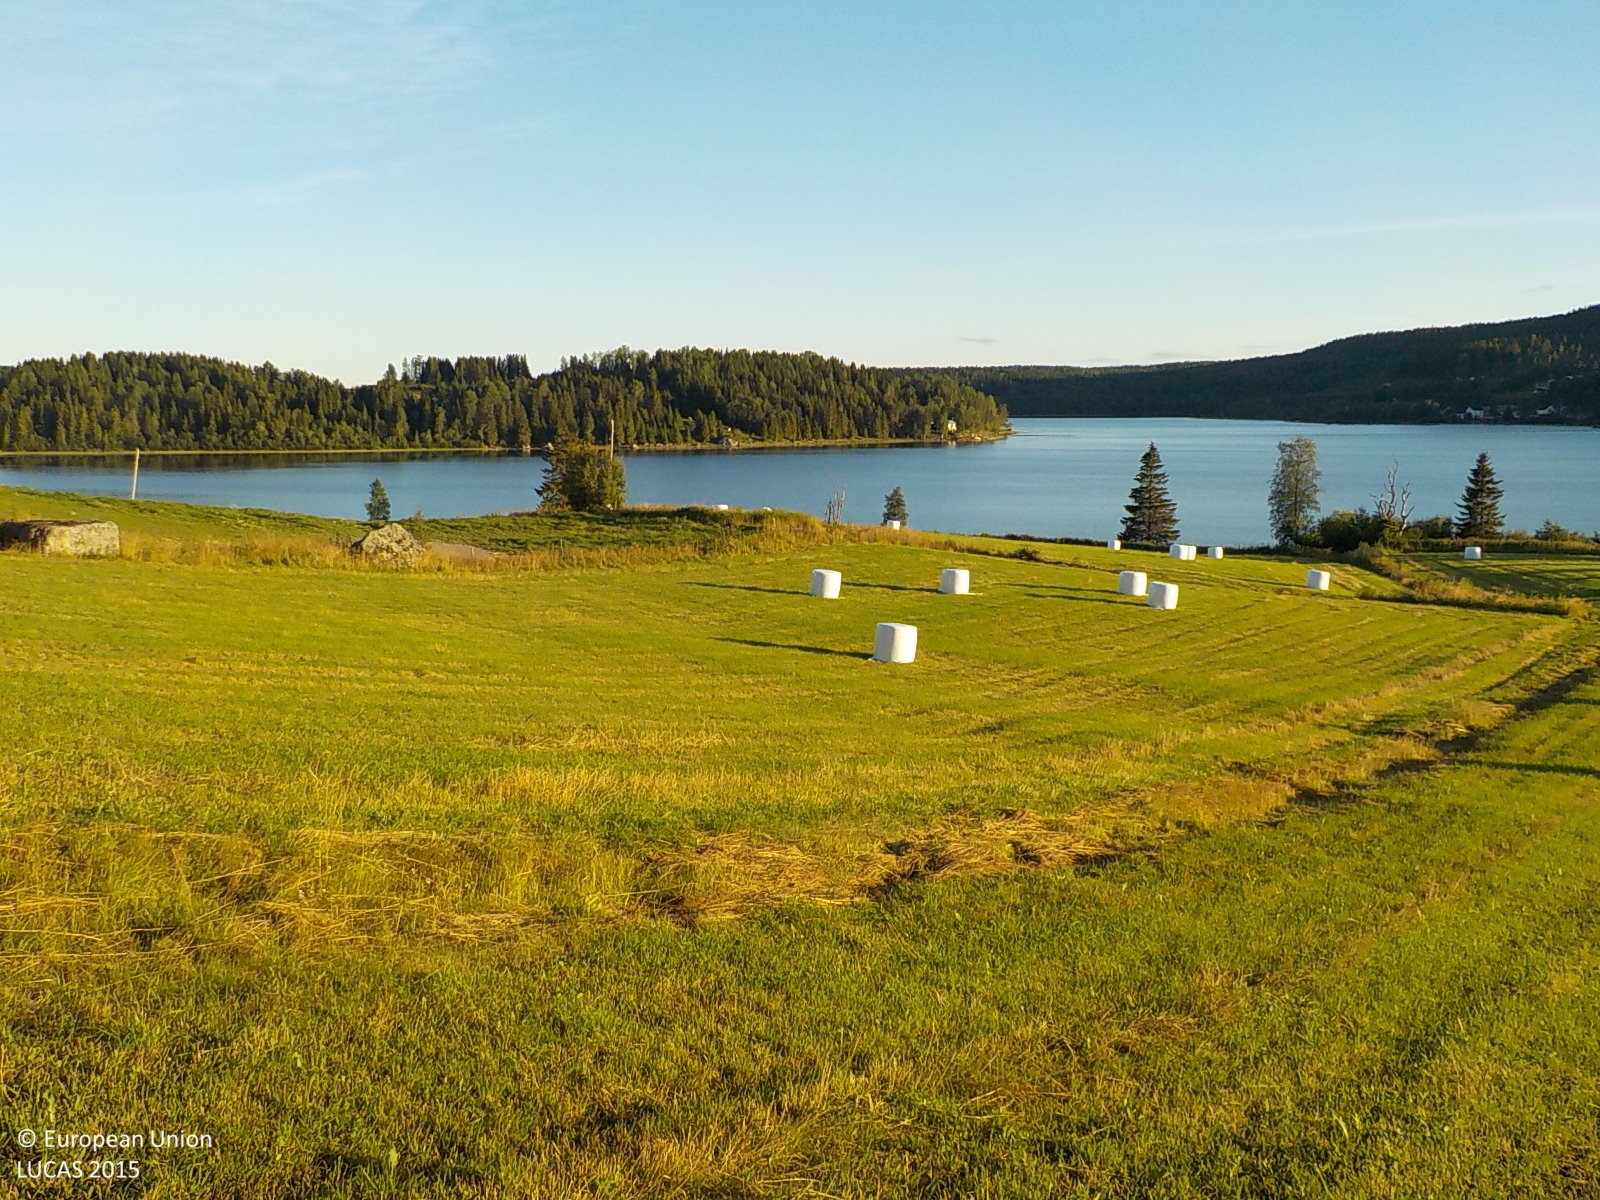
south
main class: Cropland
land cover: Other leguminous and mixtures for fodder
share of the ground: > 75 %
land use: Agriculture (excluding fallow land and kitchen gardens)
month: August
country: SE
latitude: 63.4457
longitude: 18.7792
